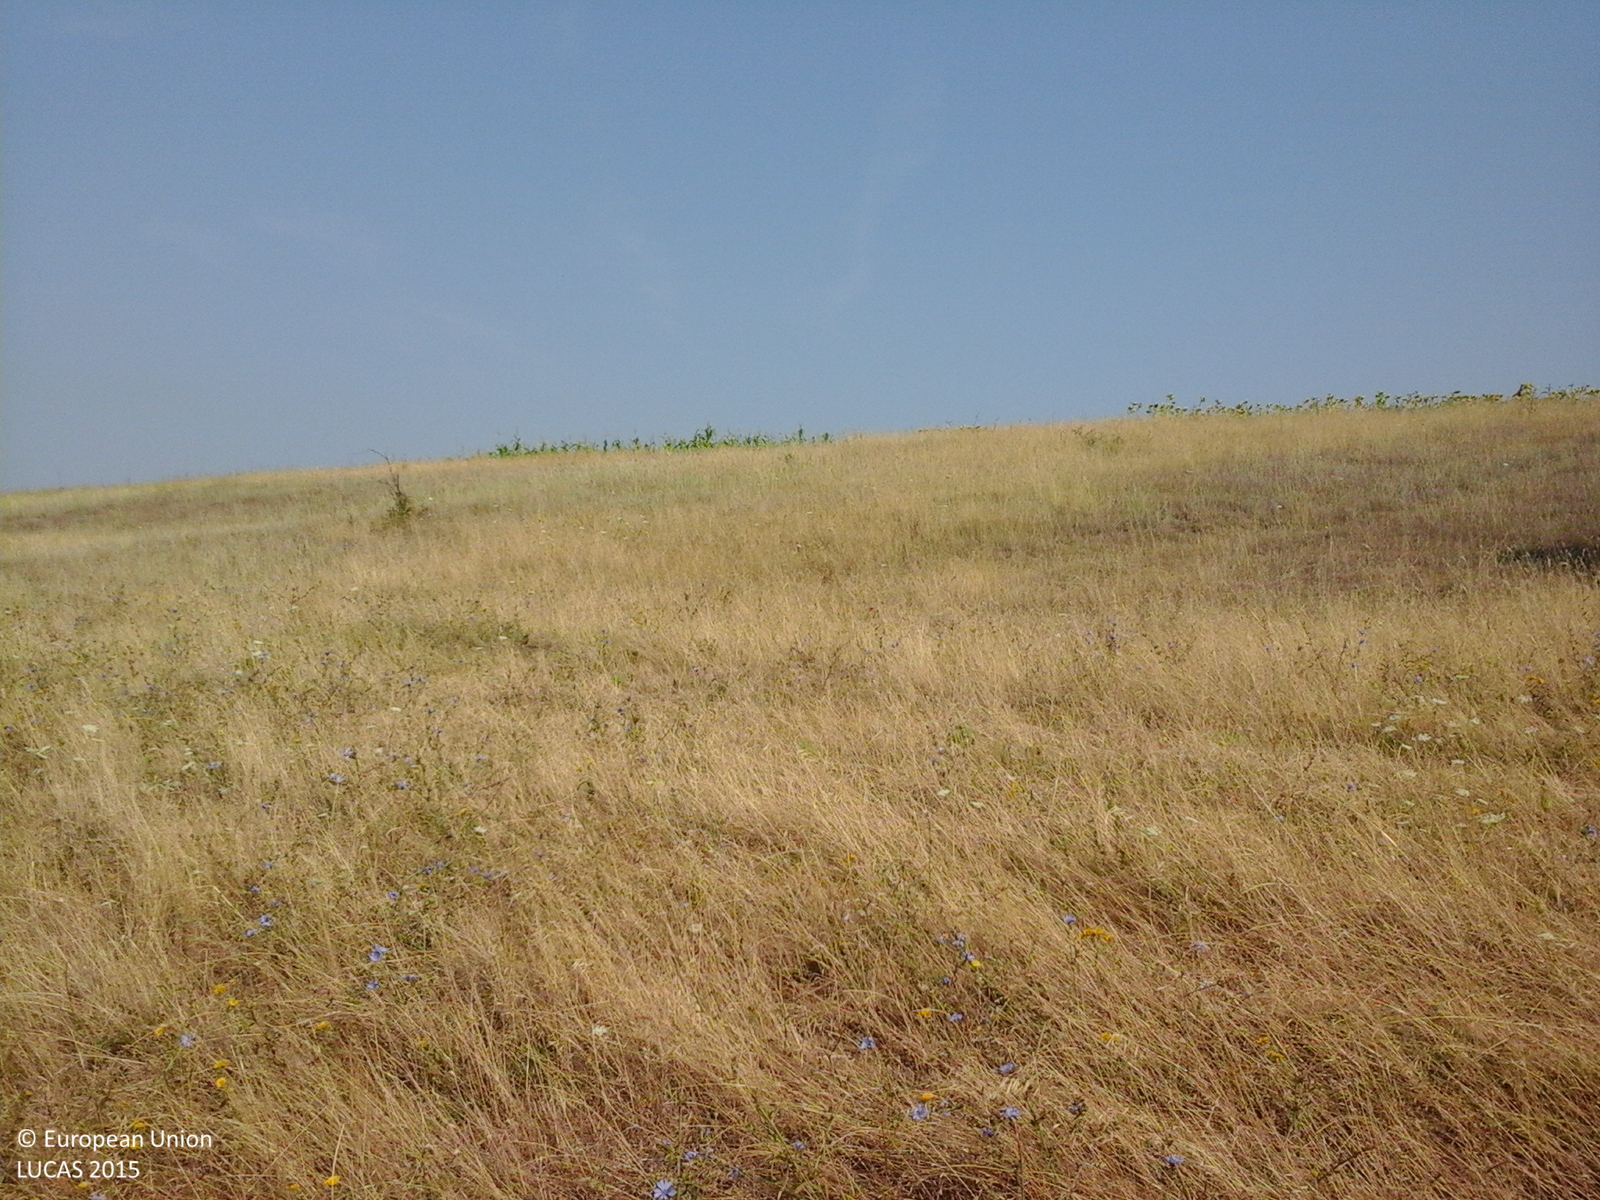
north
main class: Grassland
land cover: Grassland without tree/shrub cover
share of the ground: > 75 %
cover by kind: herbaceous plants 100 %
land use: Agriculture (excluding fallow land and kitchen gardens)
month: August
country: RO
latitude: 44.4403
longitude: 23.1517
